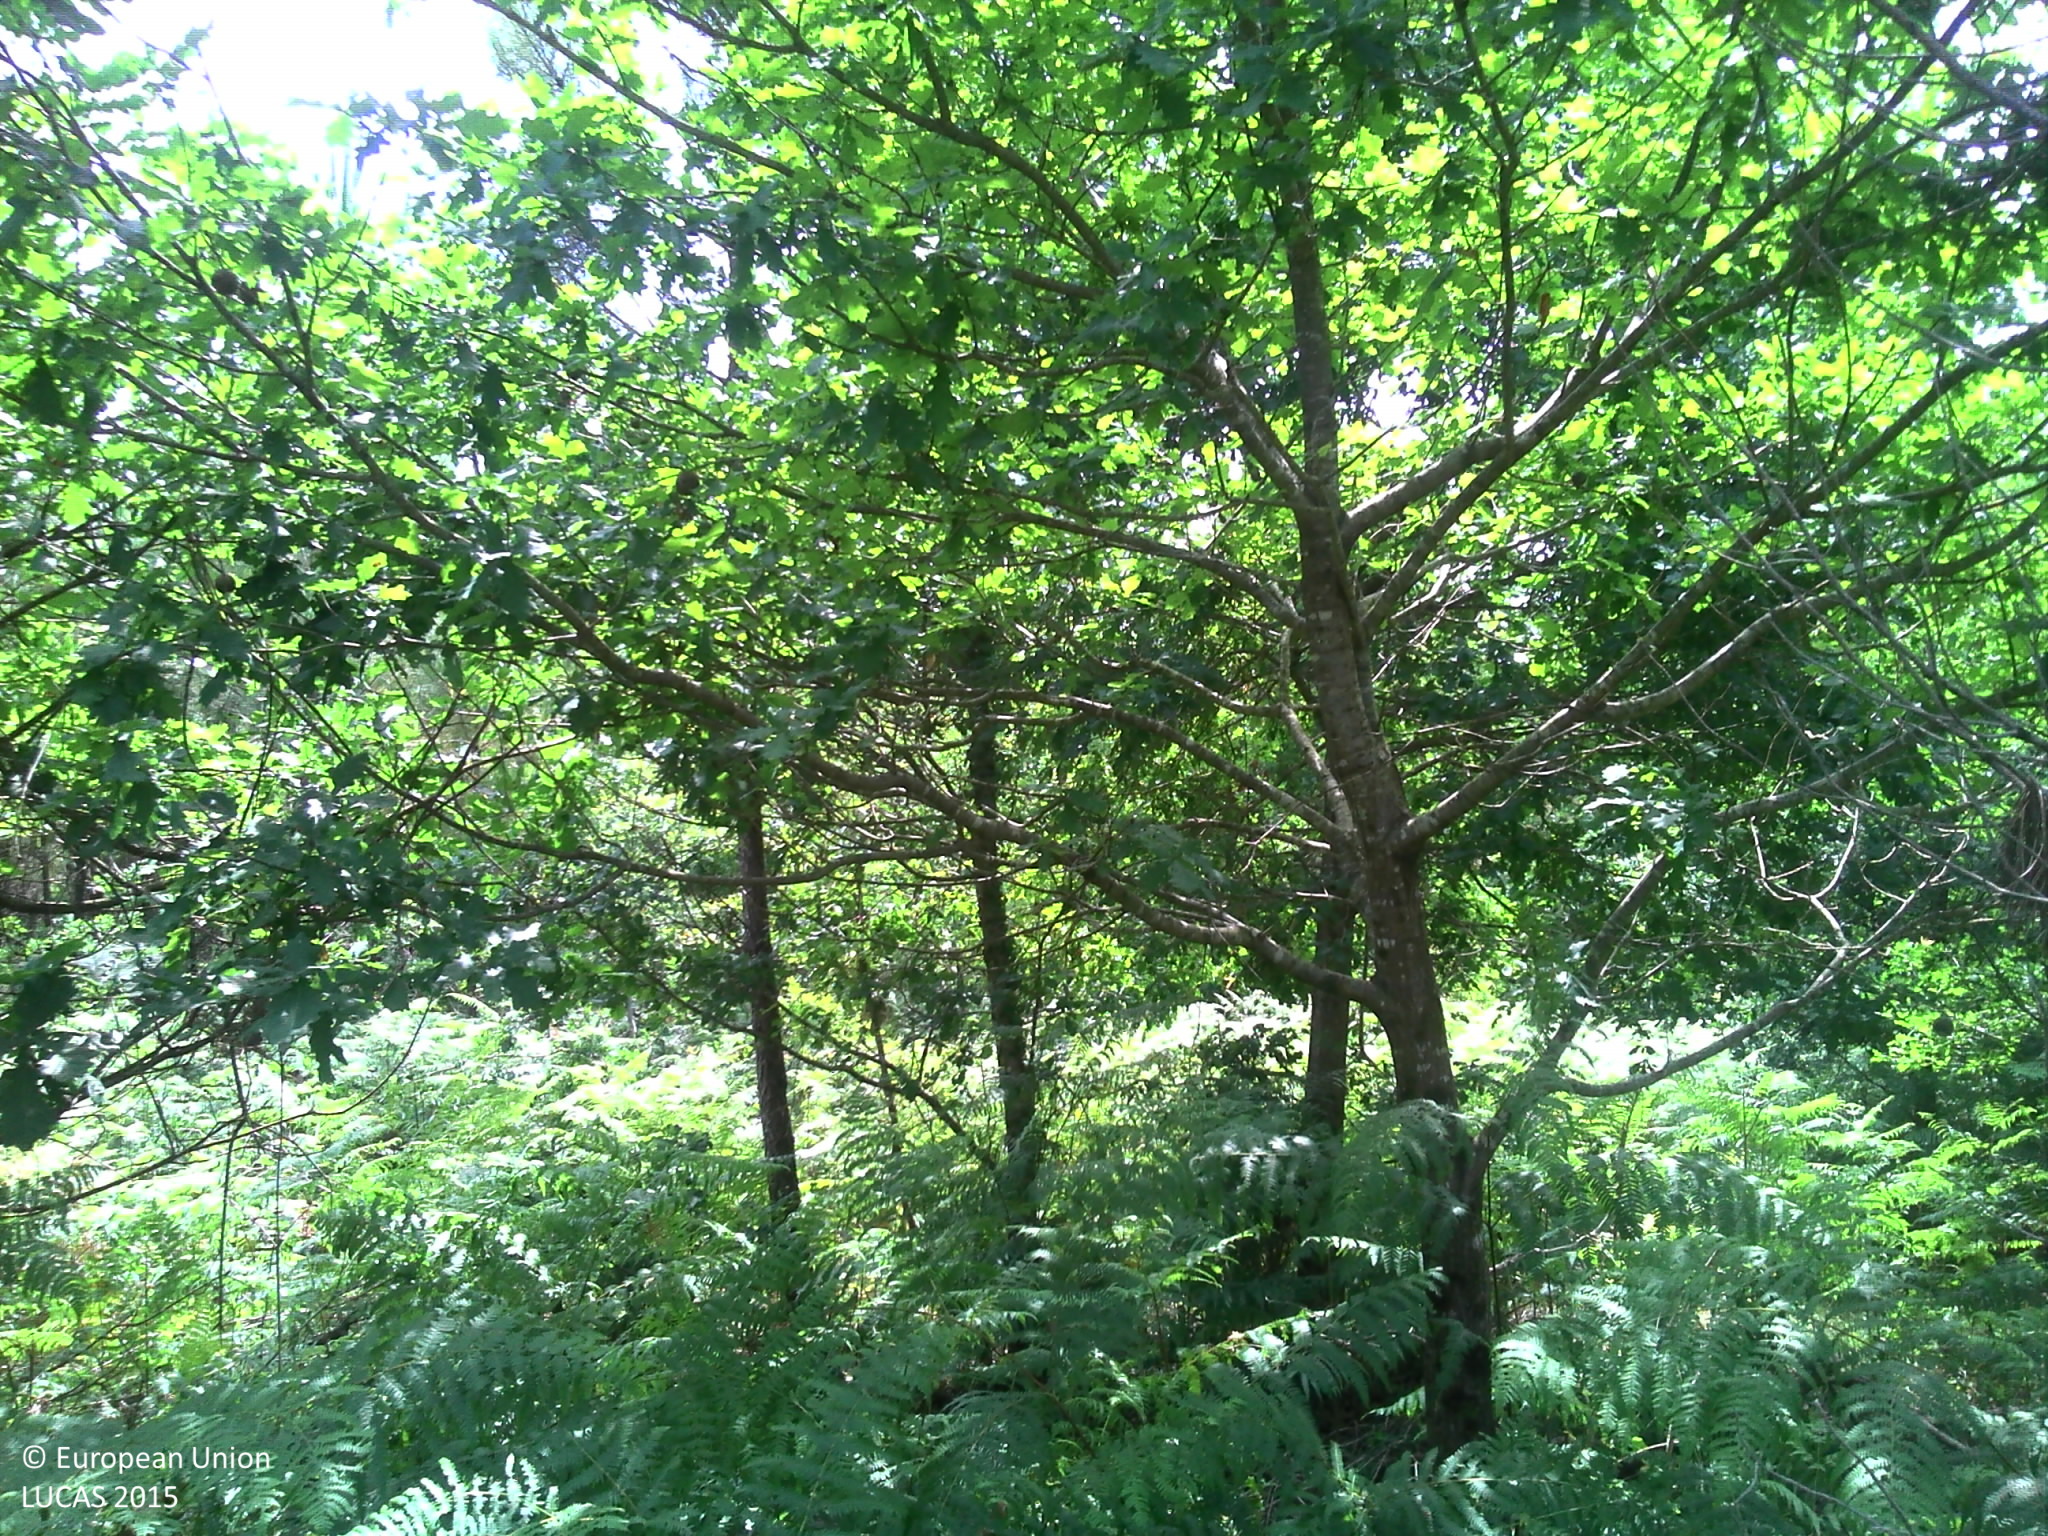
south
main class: Woodland
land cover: Pine dominated mixed woodland
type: coniferous forest of the mediterranean region
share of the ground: > 75 %
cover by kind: herbaceous plants 40 %, coniferous forest trees 30 %, broadleaved forest trees 25 %, shrubs 5 %
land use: Forestry
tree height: < 5 m
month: July
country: FR
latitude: 43.8539
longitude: -1.1770
